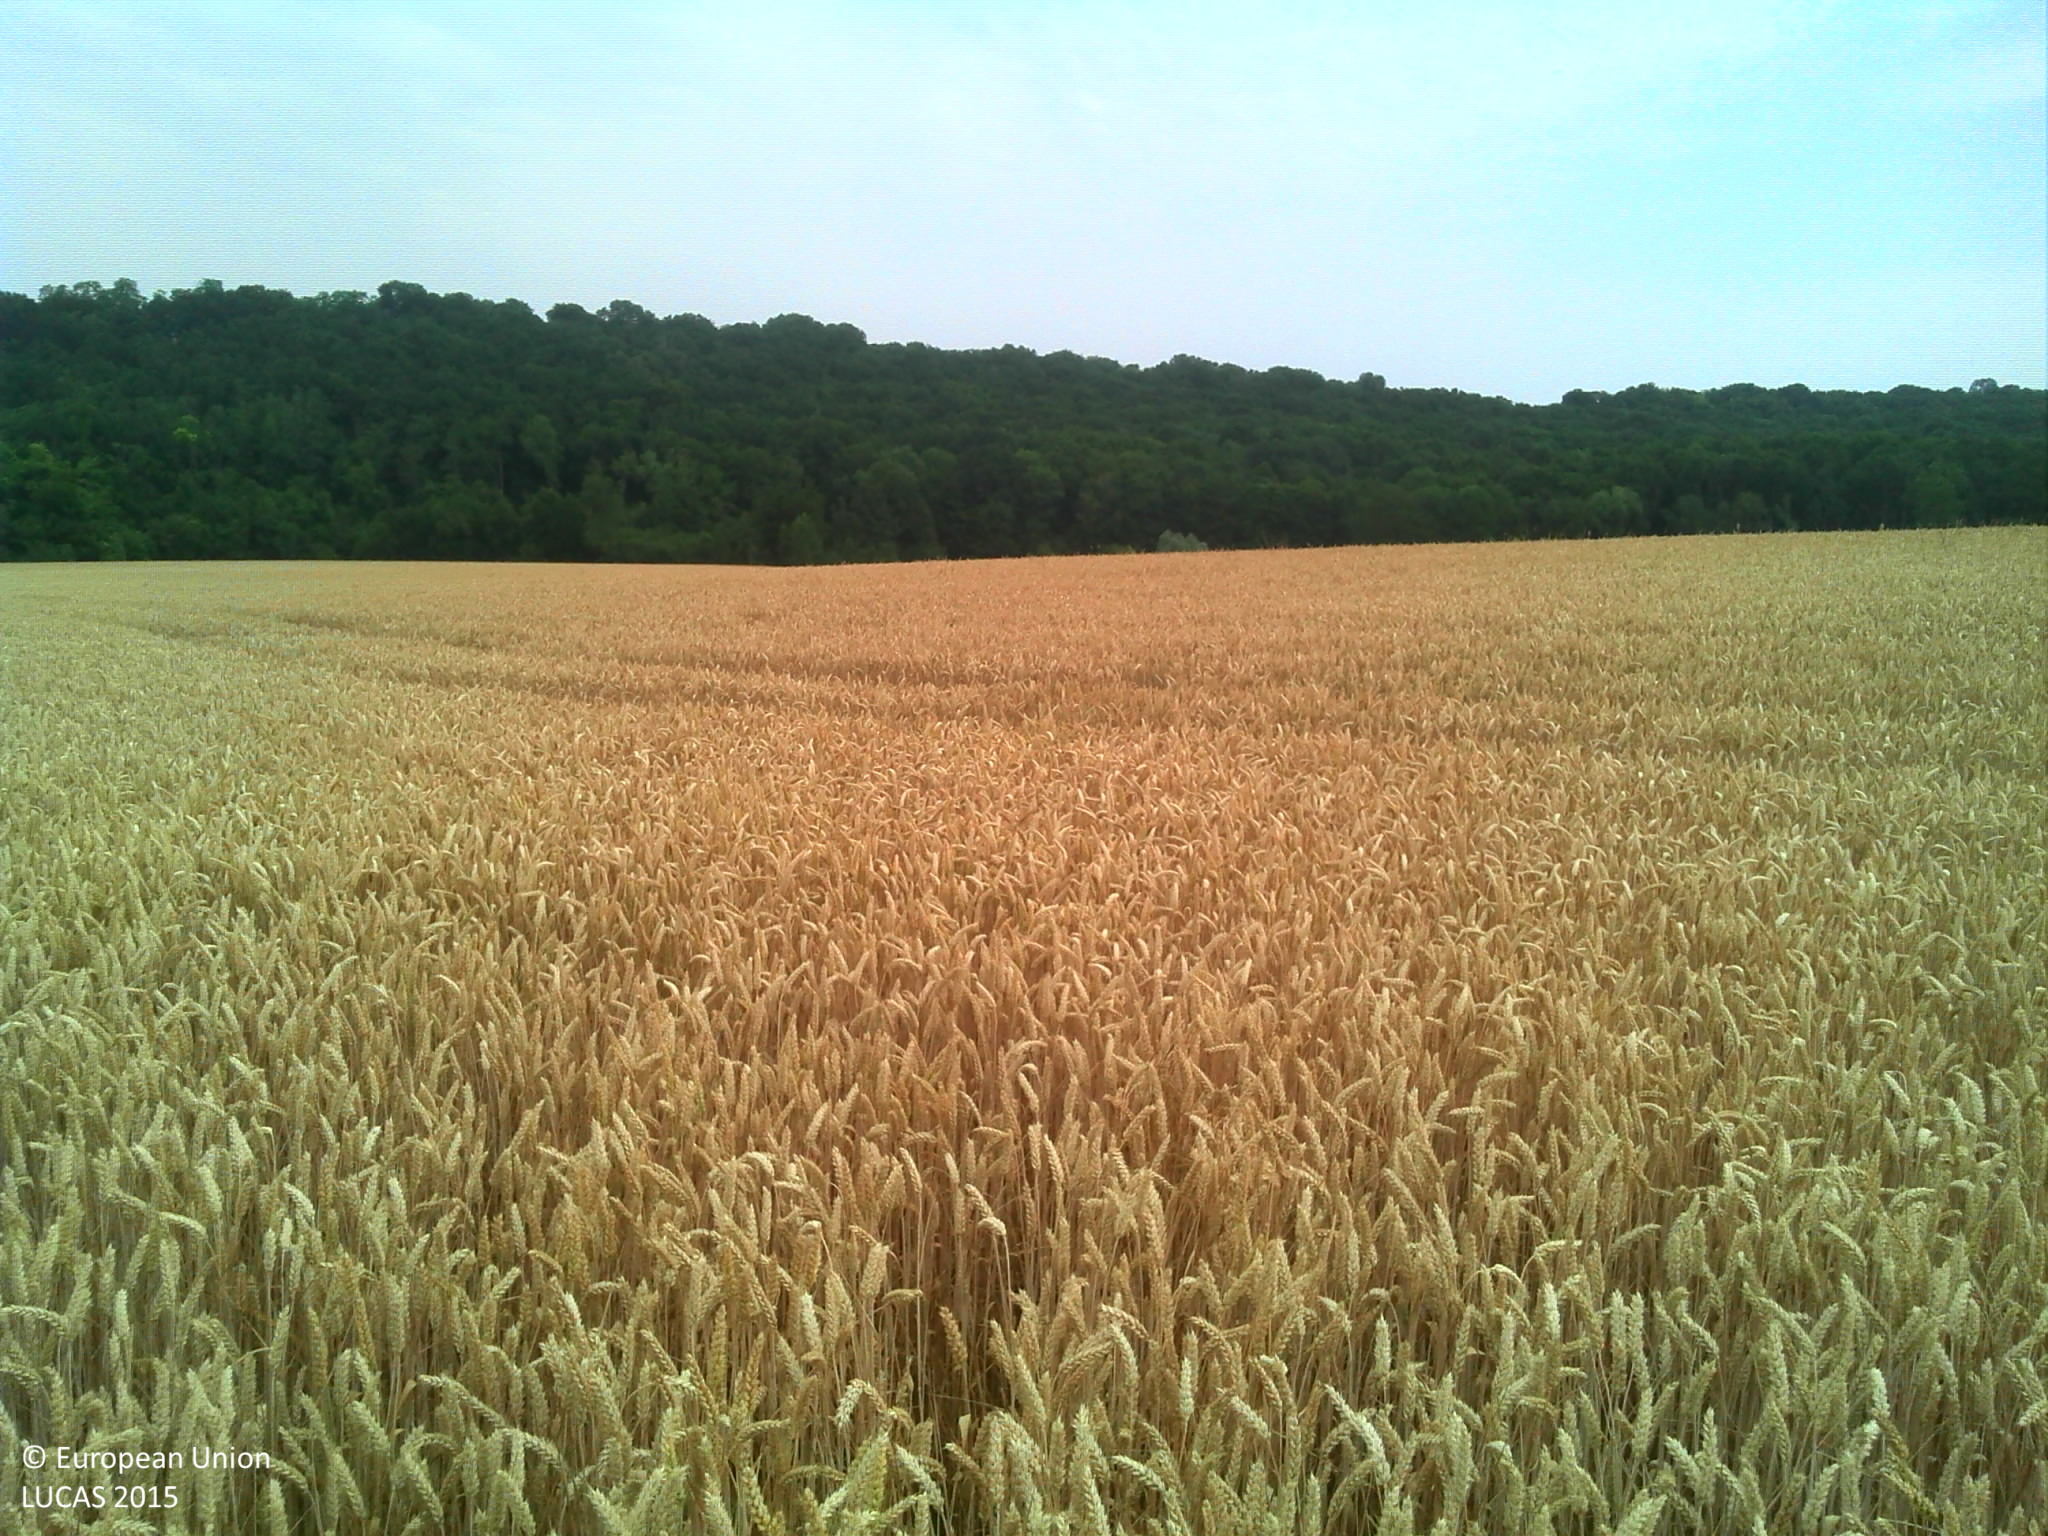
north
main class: Cropland
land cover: Common wheat
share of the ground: > 75 %
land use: Agriculture (excluding fallow land and kitchen gardens)
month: July
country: FR
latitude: 49.0862
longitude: 3.3242
